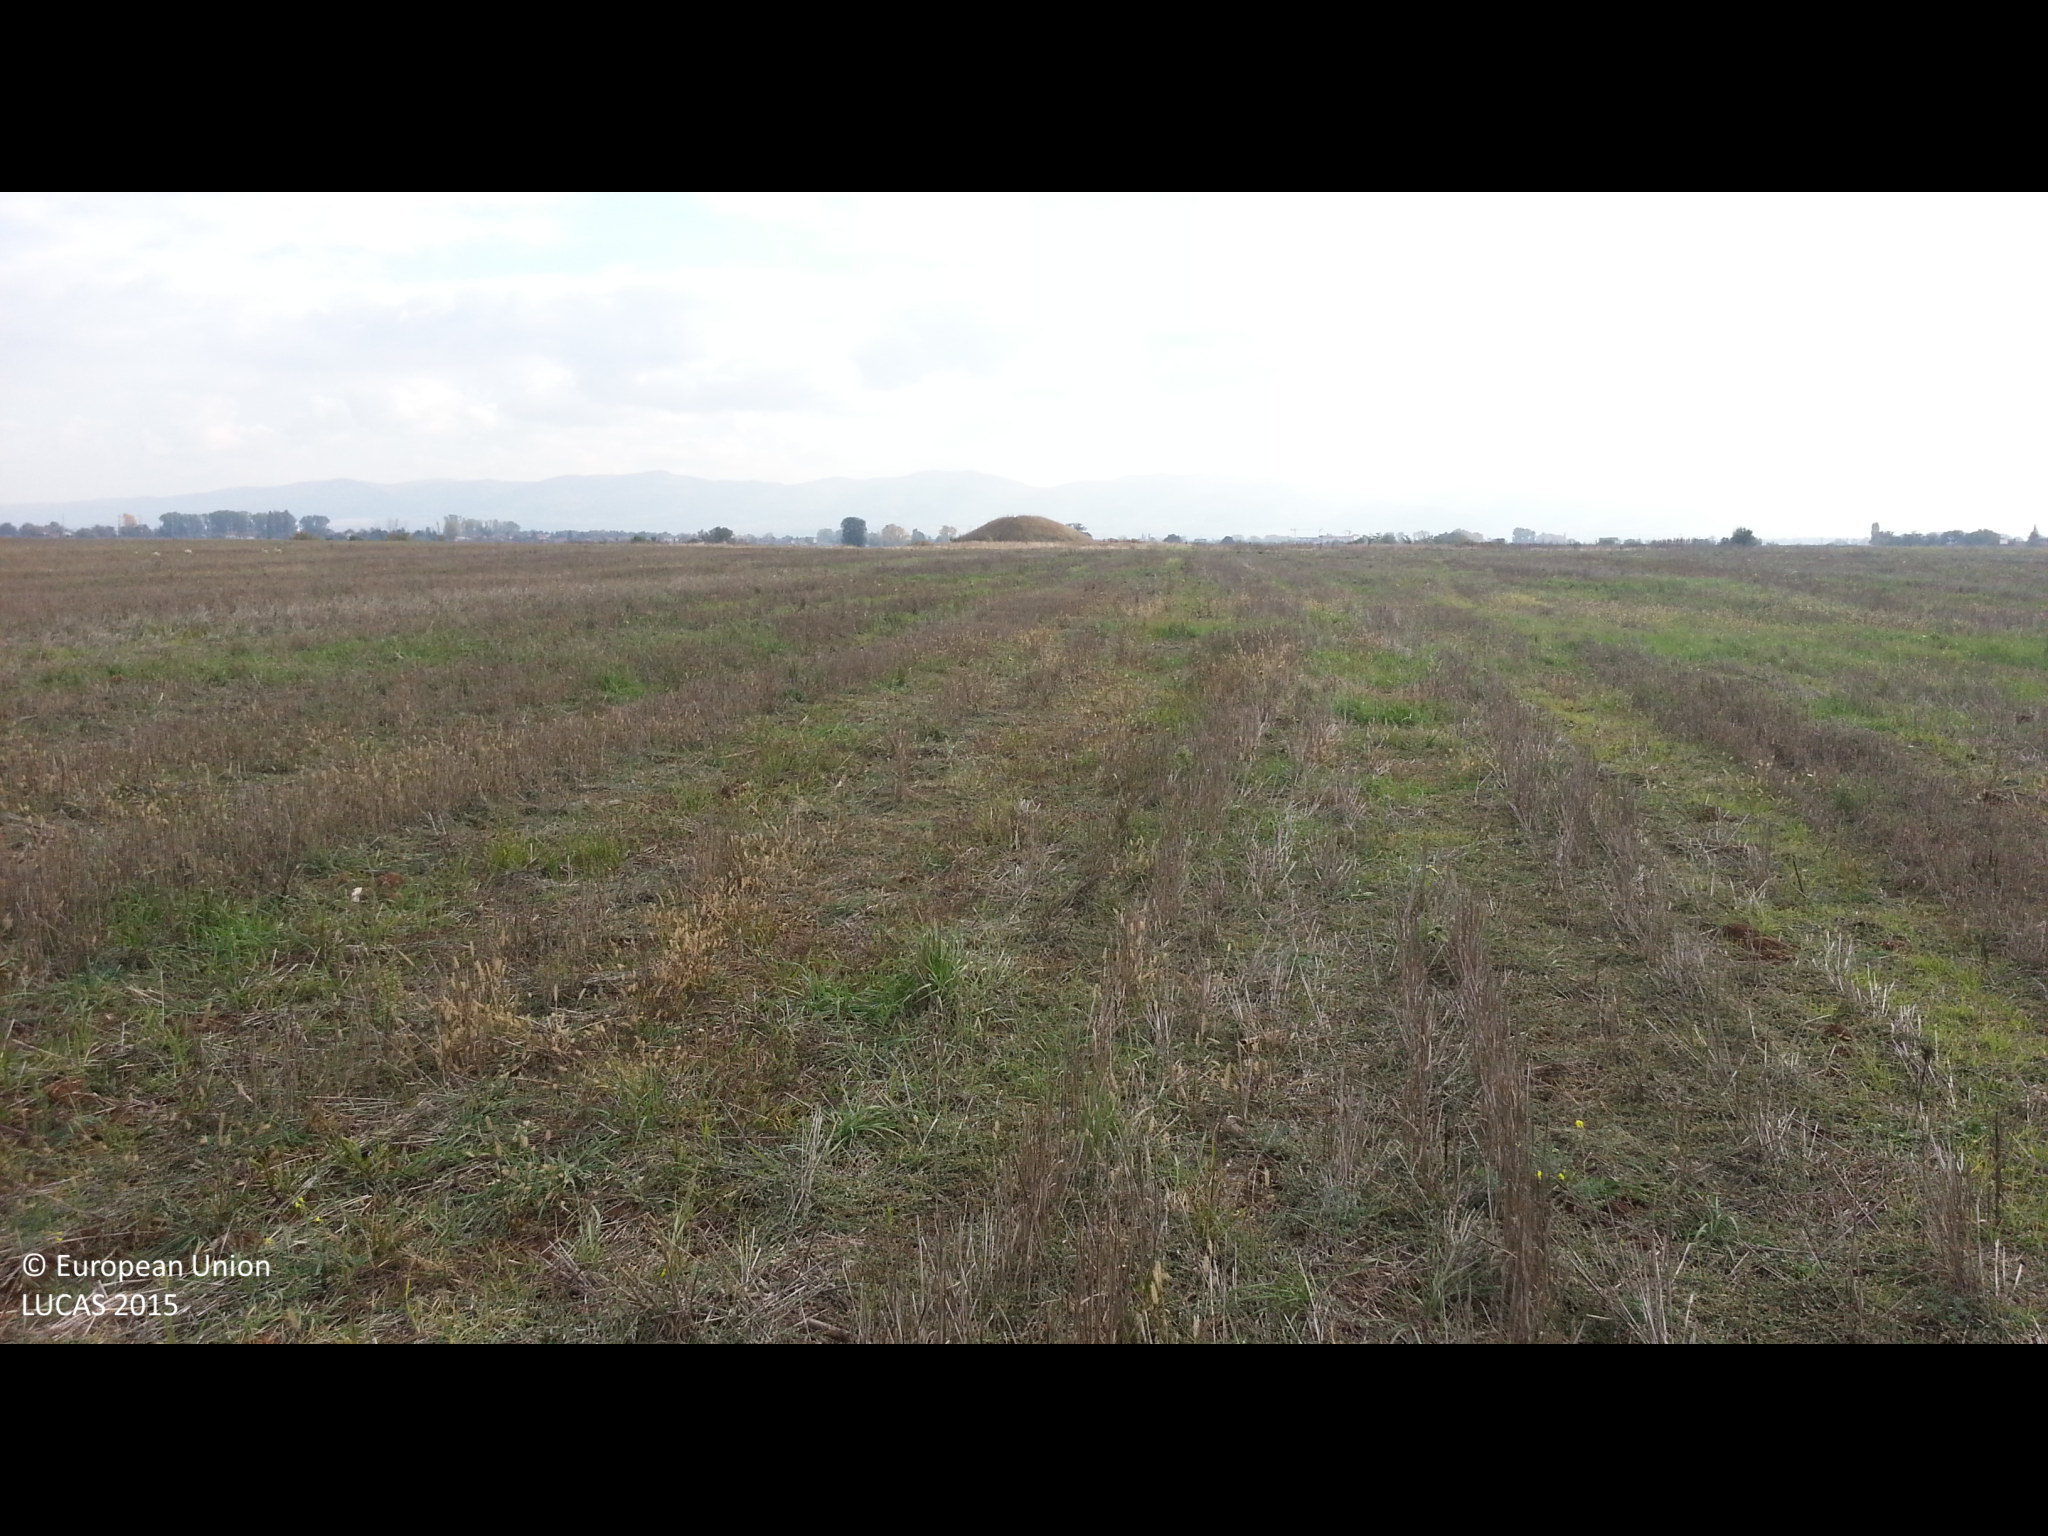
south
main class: Cropland
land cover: Common wheat
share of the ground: 10 - 25 %
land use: Agriculture (excluding fallow land and kitchen gardens)
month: October
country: BG
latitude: 42.7026
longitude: 23.4529
